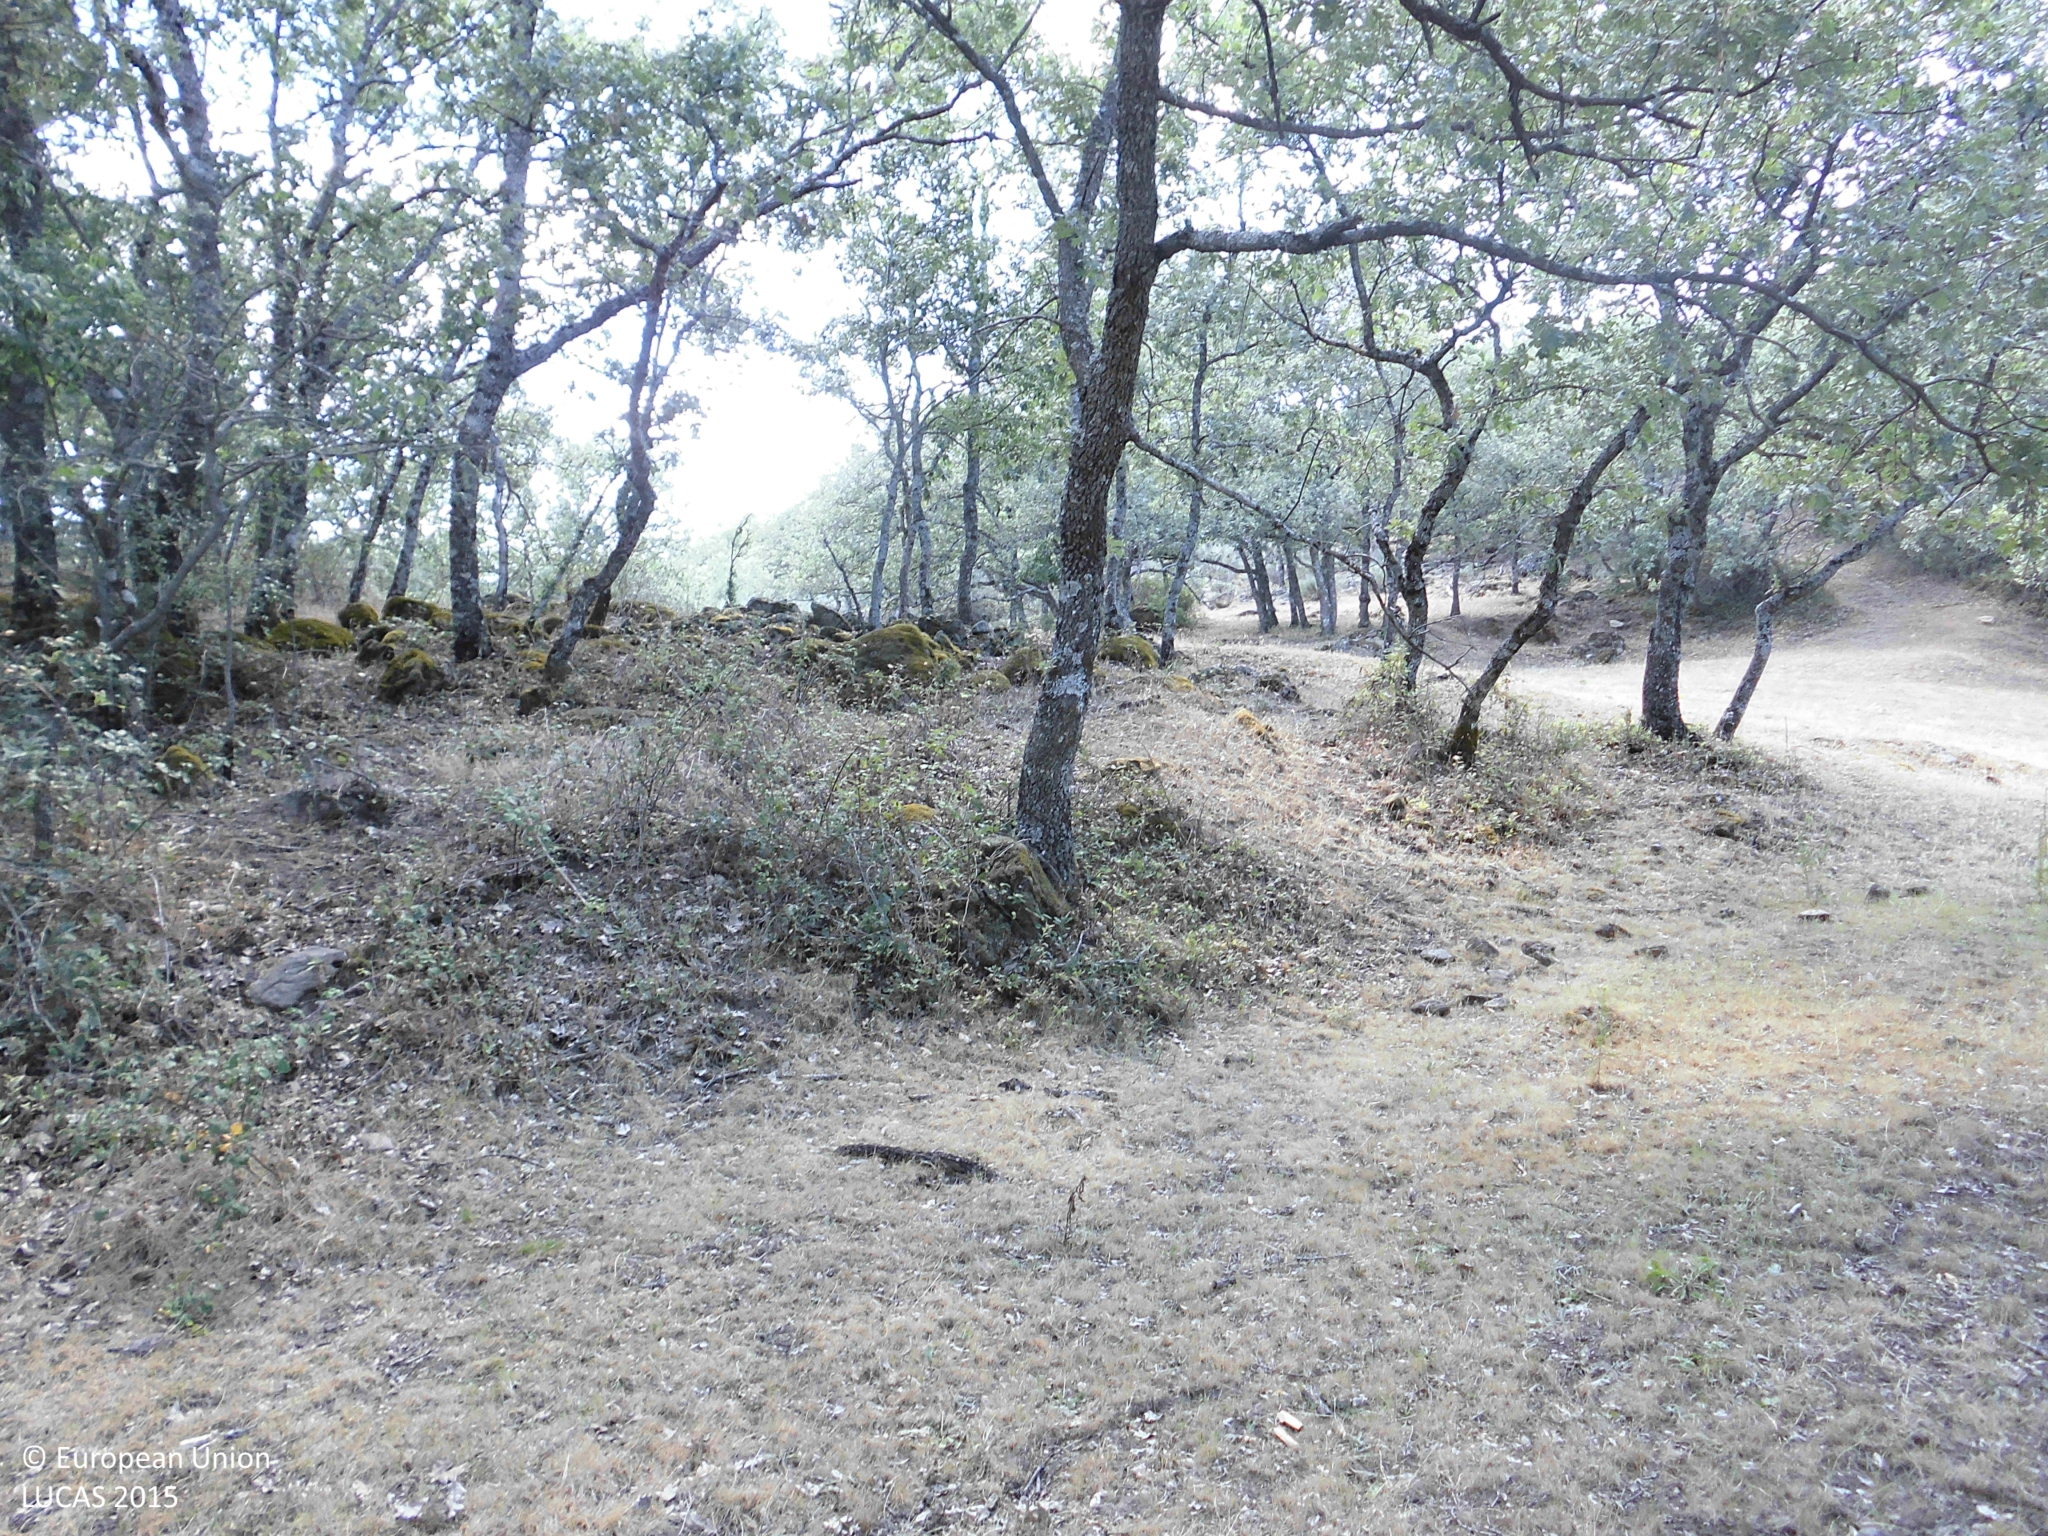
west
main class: Woodland
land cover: Broadleaved woodland
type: thermophilous deciduous forest
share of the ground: > 75 %
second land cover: Grassland without tree/shrub cover
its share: > 75 %
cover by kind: broadleaved forest trees 80 %, herbaceous plants 20 %
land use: Forestry
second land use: Agriculture (excluding fallow land and kitchen gardens)
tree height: > 5 m
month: June
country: ES
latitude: 40.0386
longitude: -5.9493
